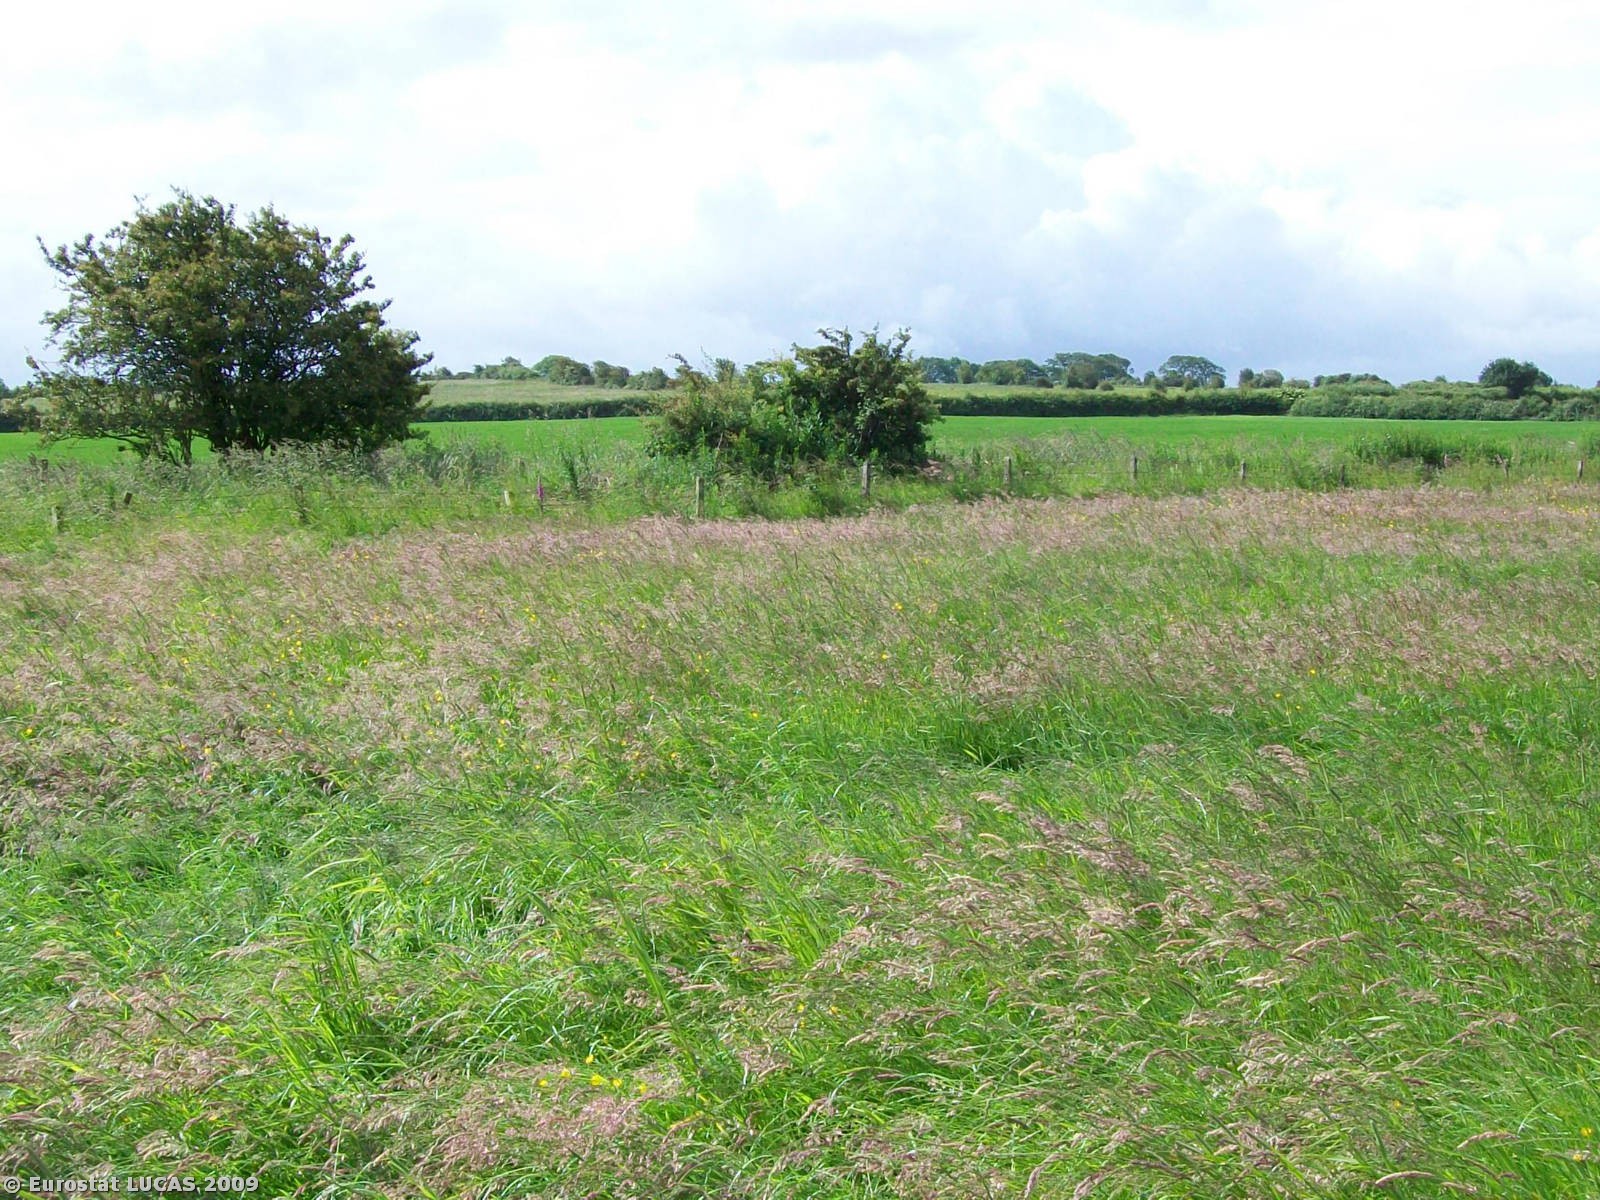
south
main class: Grassland
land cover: Grassland without tree/shrub cover
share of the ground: > 75 %
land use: Agriculture (excluding fallow land and kitchen gardens)
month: June
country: GB
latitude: 54.8767
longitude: -3.2456
